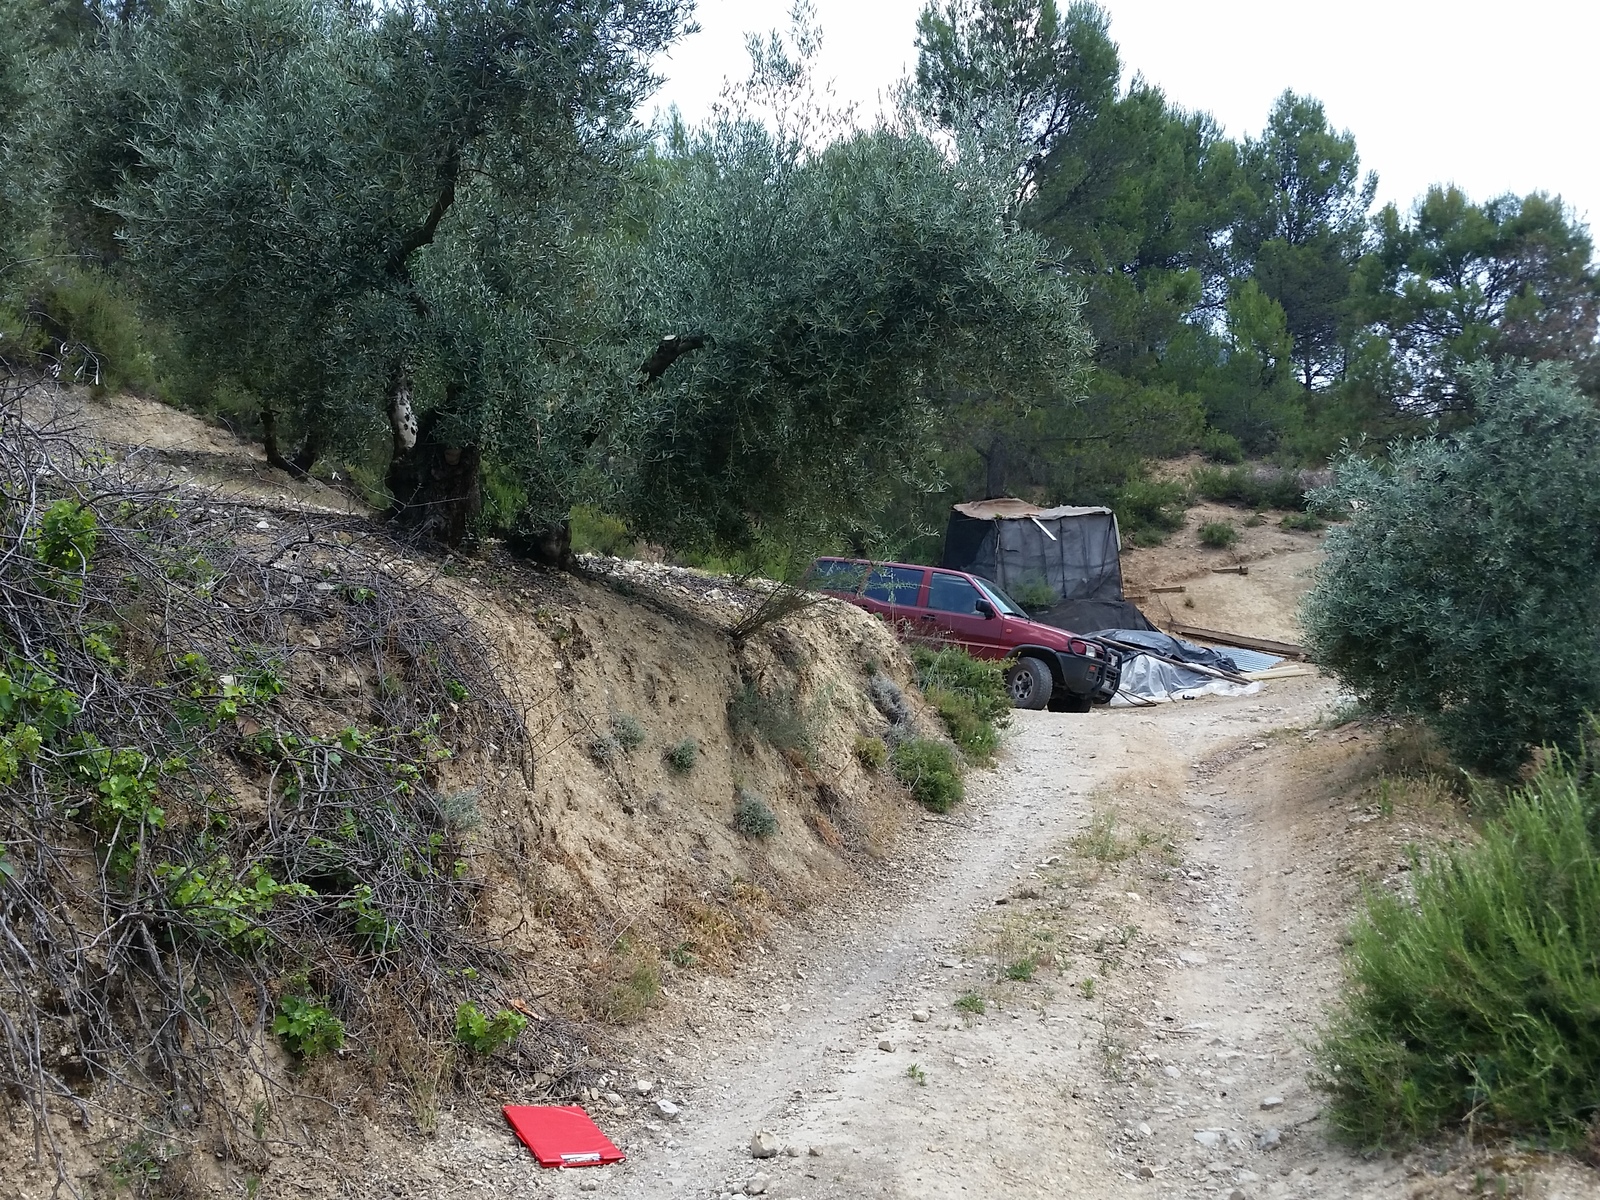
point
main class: Cropland
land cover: Olive groves
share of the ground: 50 - 75 %
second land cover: Other bare soil
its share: > 75 %
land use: Agriculture (excluding fallow land and kitchen gardens)
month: June
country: ES
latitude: 38.3747
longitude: -2.5777
